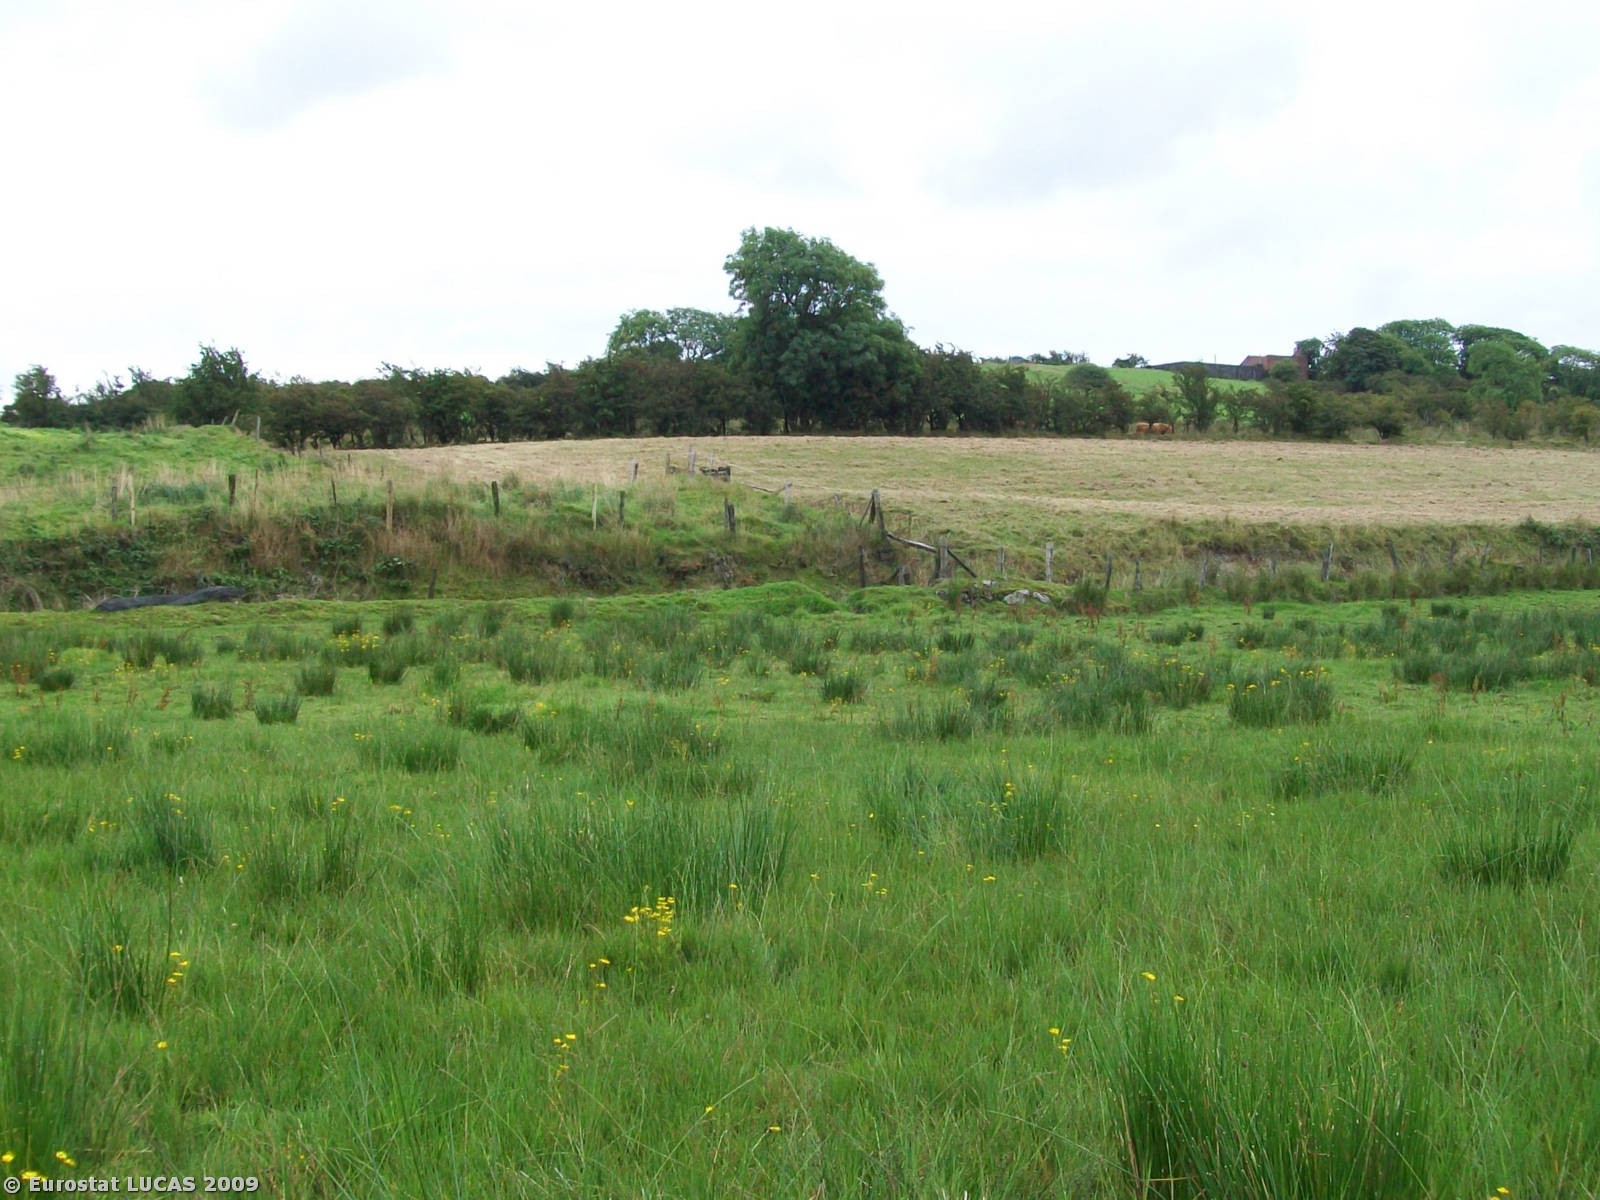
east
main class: Grassland
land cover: Grassland without tree/shrub cover
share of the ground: > 75 %
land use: Agriculture (excluding fallow land and kitchen gardens)
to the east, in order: Grassland without tree/shrub cover; Rivers and streams; Grass margins; Fences; Grass margins; Fences; Grassland without tree/shrub cover; Fences; Grass margins; Ditches and canals; Grassland without tree/shrub cover; Broadleaved woodland; Ditches and canals; Broadleaved woodland; Grassland without tree/shrub cover; Fences; Broadleaved woodland; Ditches and canals; Grassland without tree/shrub cover
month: August
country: GB
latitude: 54.2152
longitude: -6.7084
